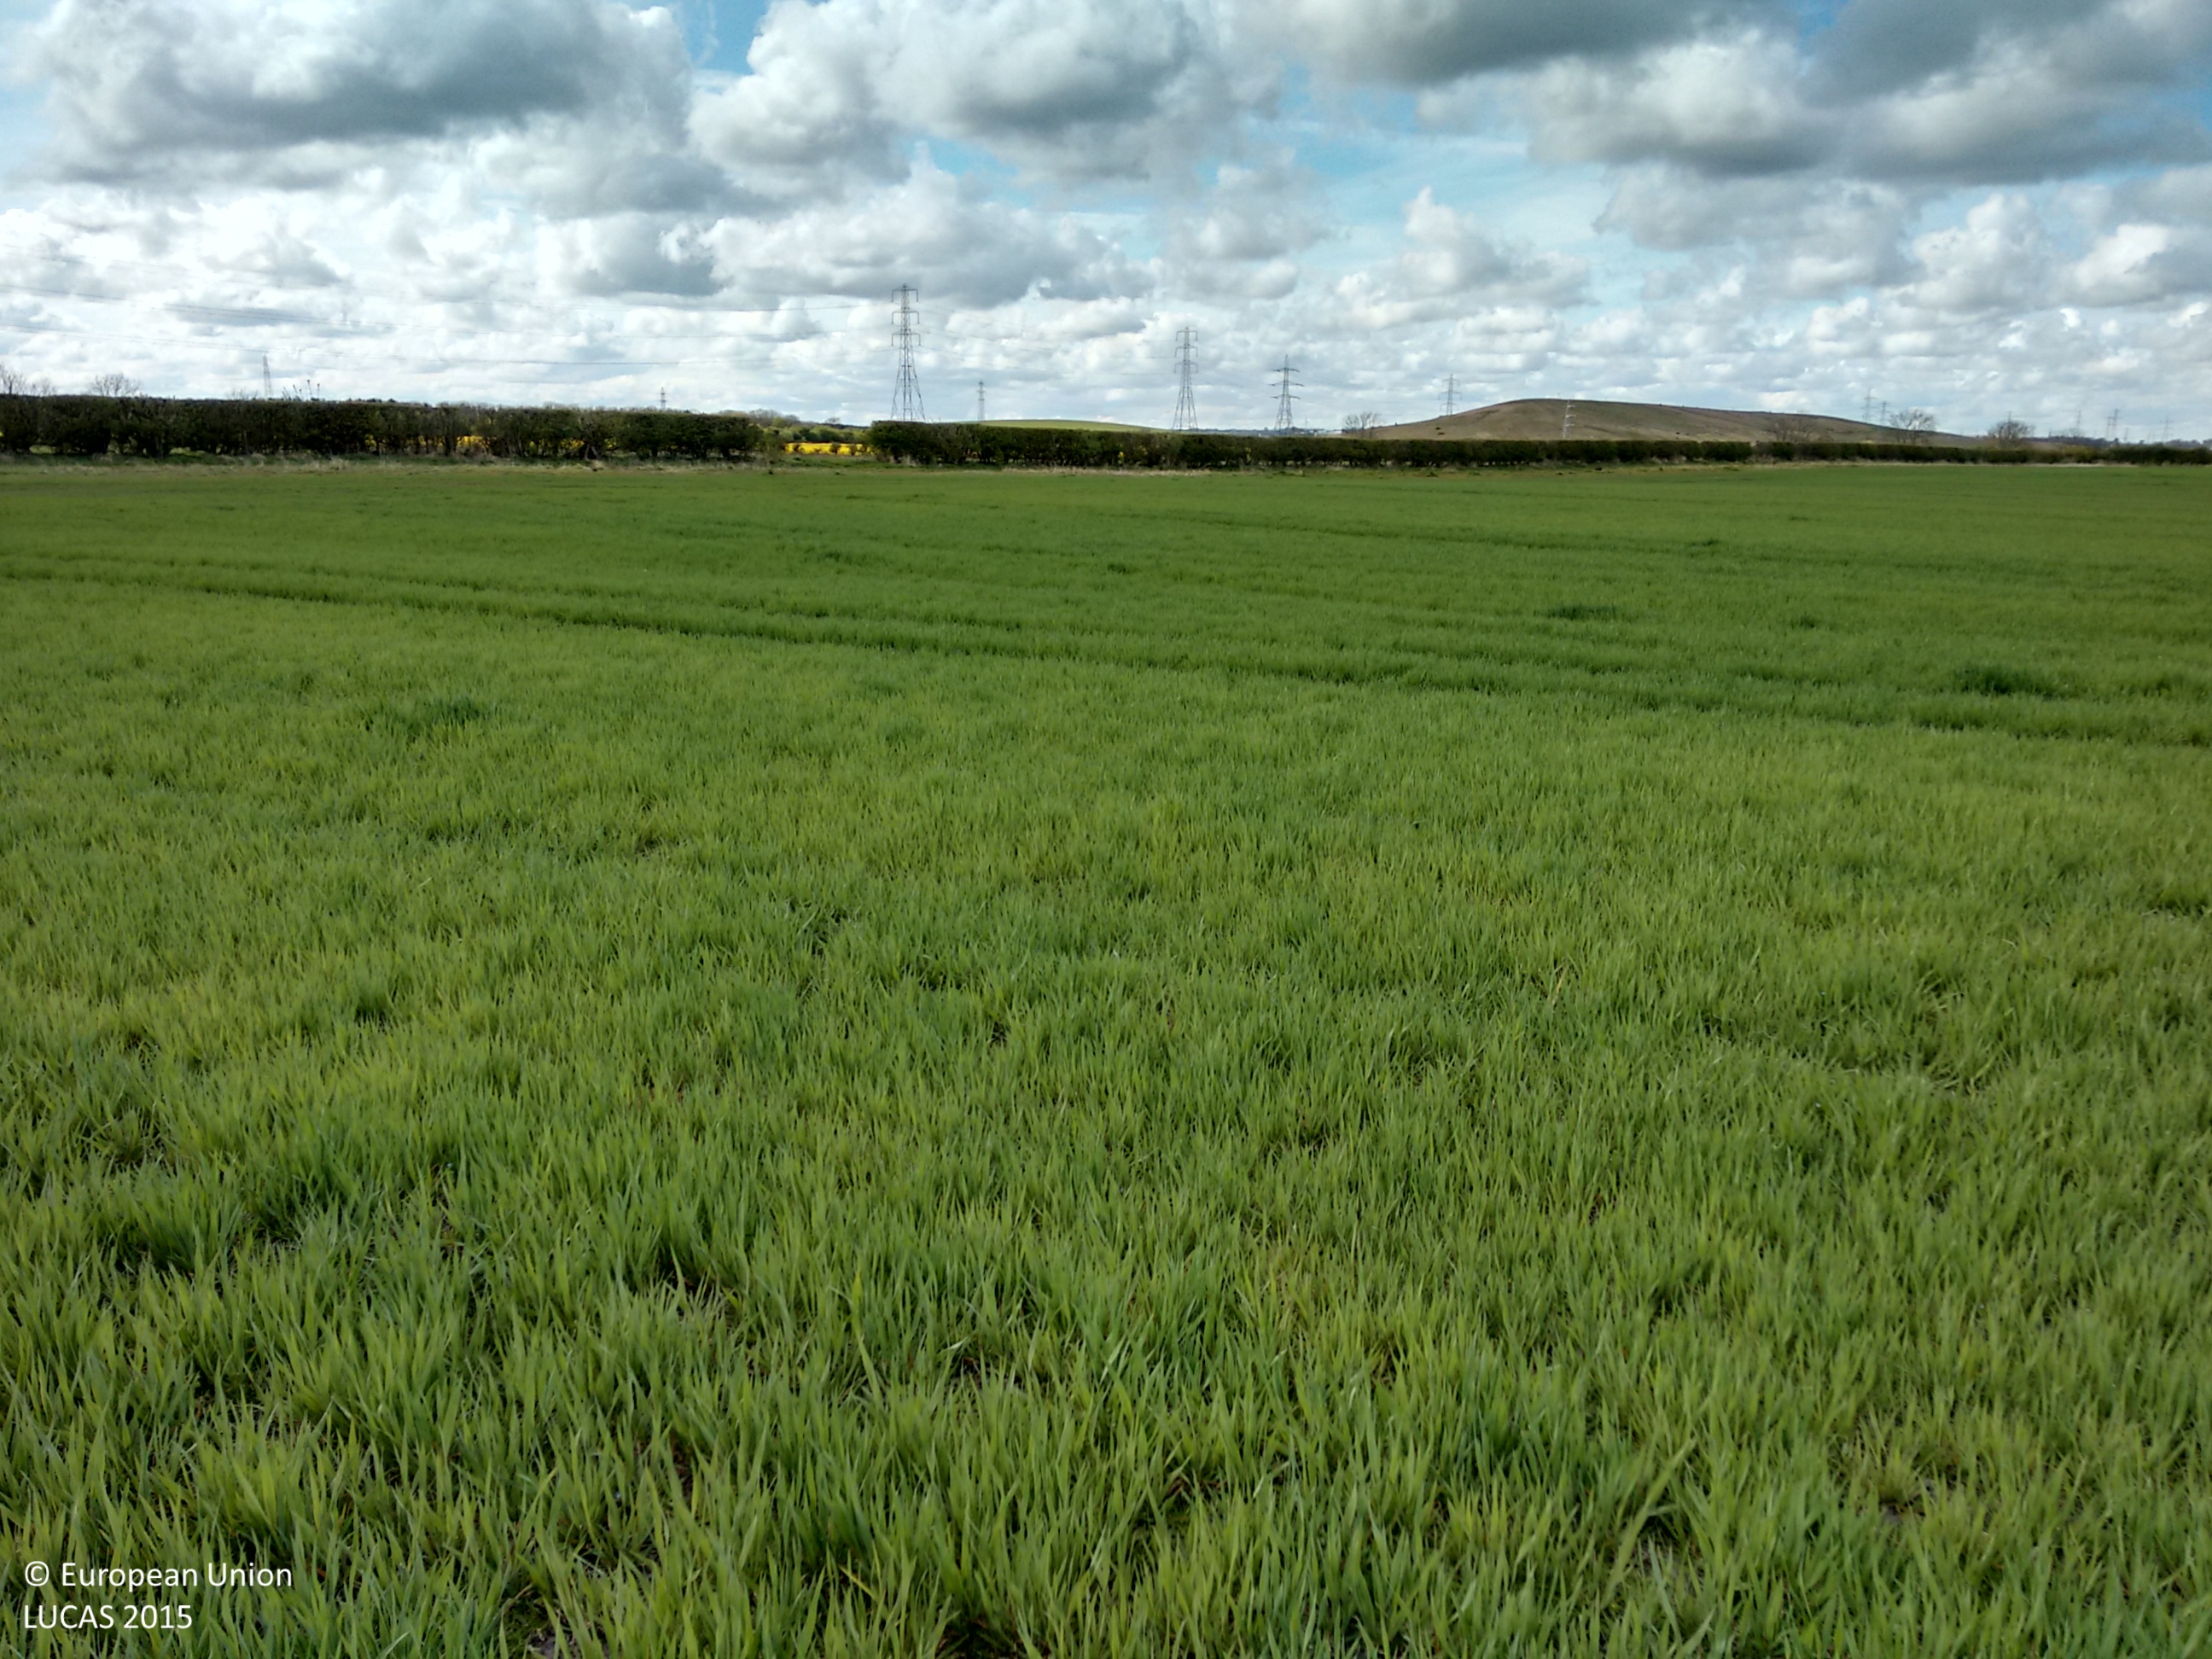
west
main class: Cropland
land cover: Oats
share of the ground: > 75 %
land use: Agriculture (excluding fallow land and kitchen gardens)
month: May
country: GB
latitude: 55.0488
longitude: -1.5203
